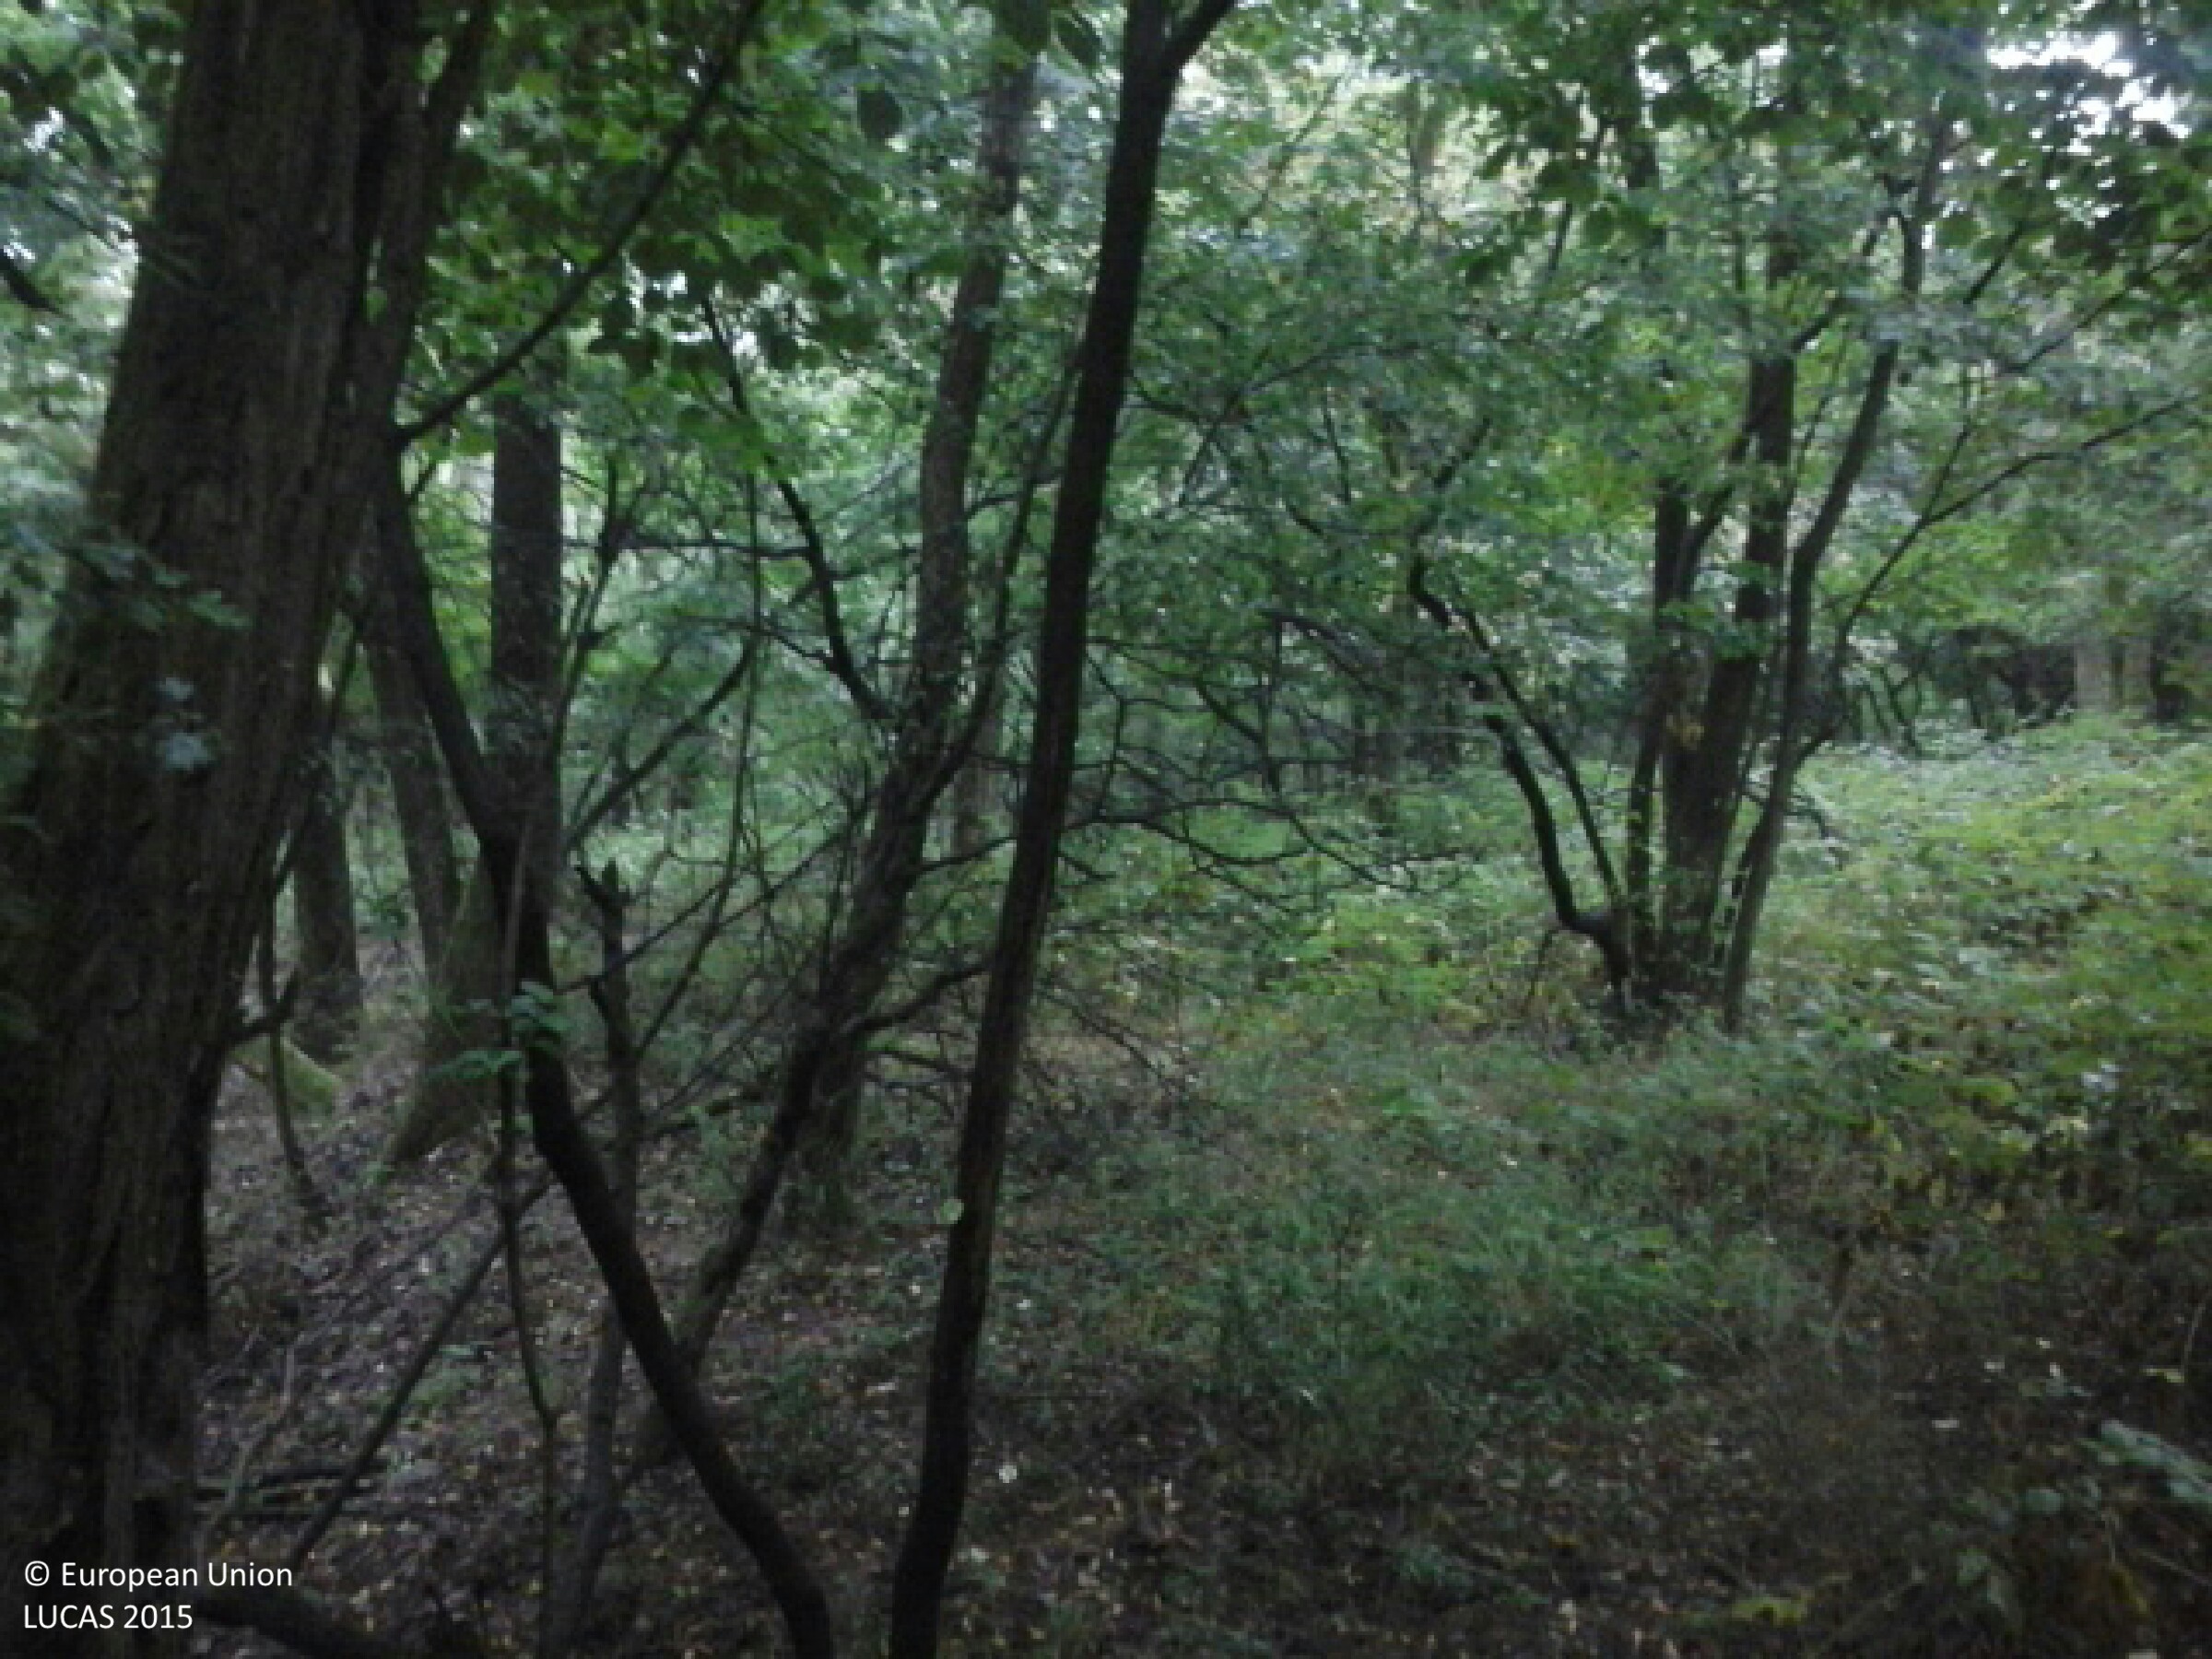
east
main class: Woodland
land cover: Broadleaved woodland
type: mesophytic deciduous forest
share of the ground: > 75 %
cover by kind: broadleaved forest trees 95 %, shrubs 5 %
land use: Forestry
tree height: > 5 m
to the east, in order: Broadleaved woodland; Ditches and canals; Broadleaved woodland; Ditches and canals; Broadleaved woodland; Ditches and canals; Broadleaved woodland
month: July
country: HU
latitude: 48.5031
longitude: 21.5658
